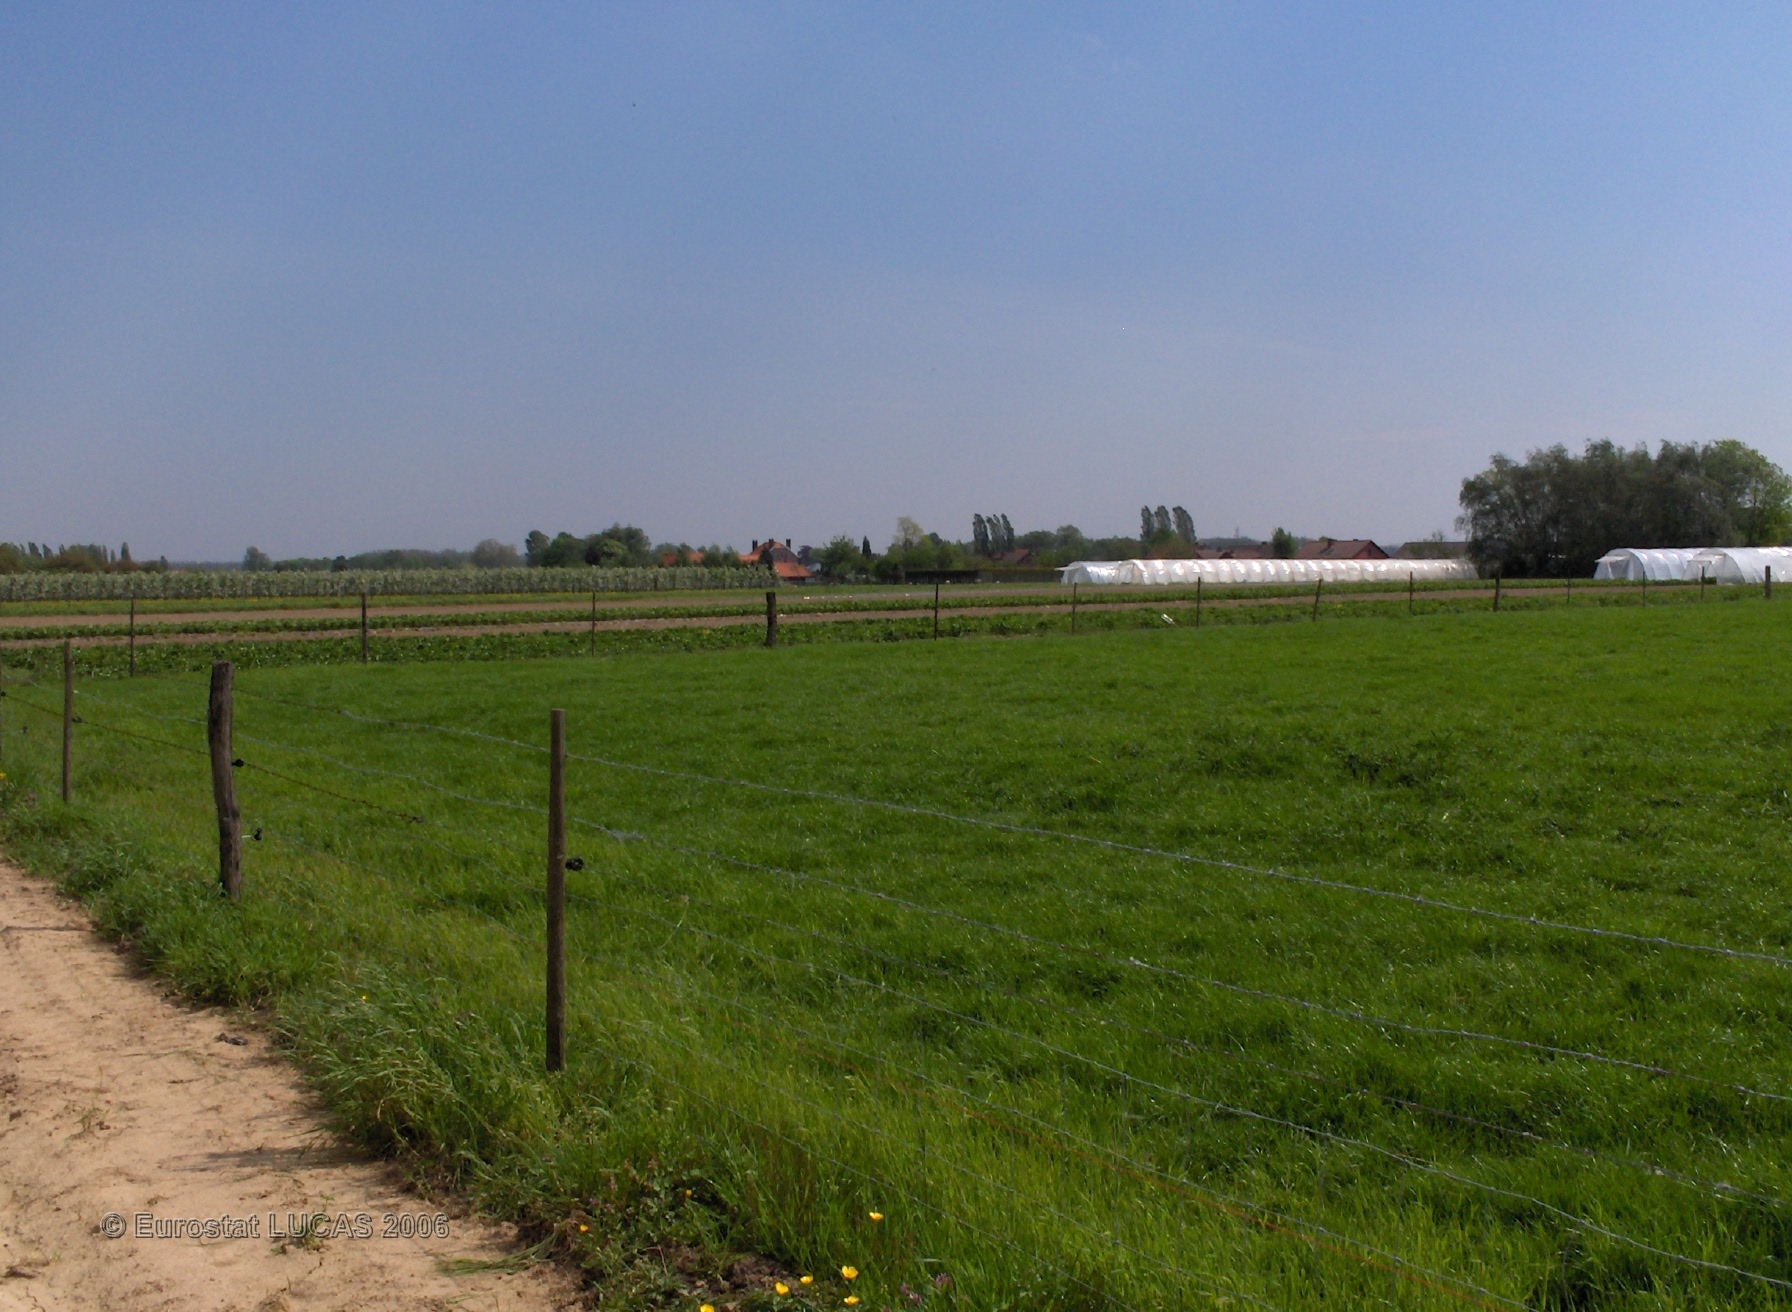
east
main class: Bare land
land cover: Bare land
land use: Agriculture (excluding fallow land and kitchen gardens)
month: May
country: BE
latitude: 50.9131
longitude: 5.2329
